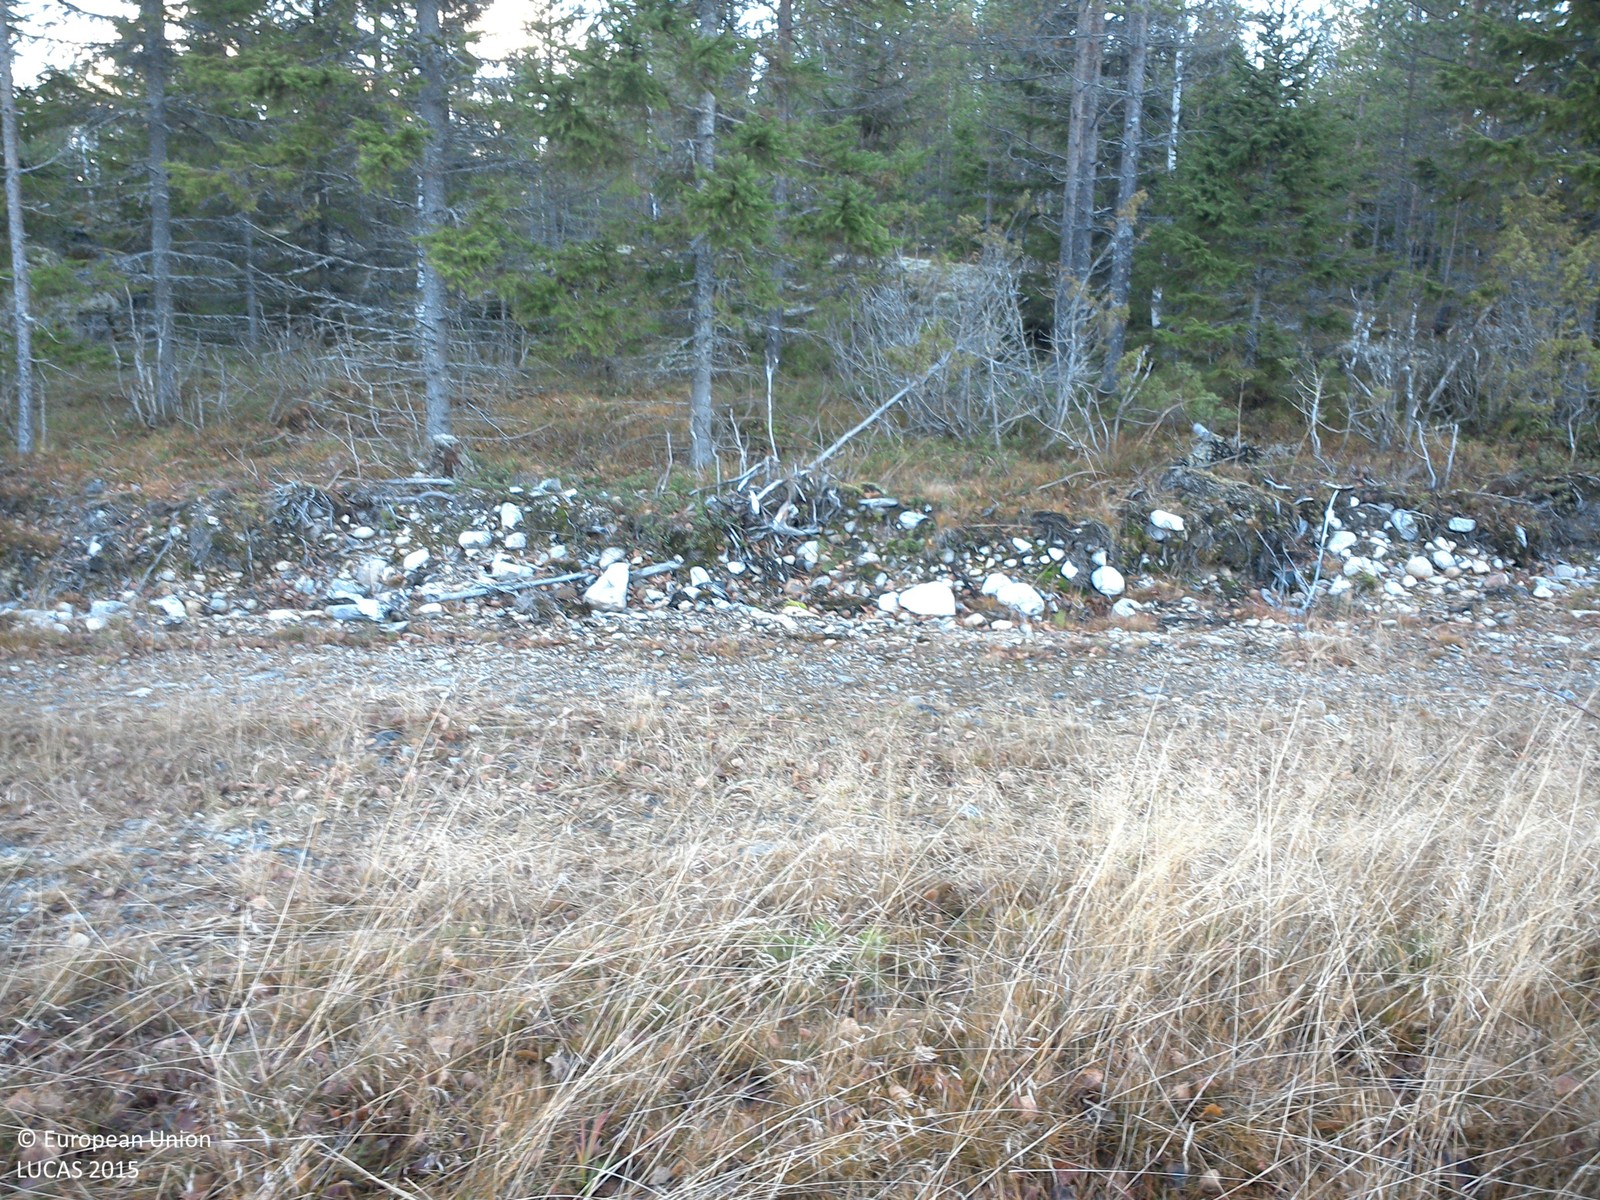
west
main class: Woodland
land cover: Pine dominated coniferous woodland
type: boreal forest
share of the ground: 25 - 50 %
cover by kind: shrubs 40 %, herbaceous plants 30 %, coniferous forest trees 25 %, broadleaved forest trees 5 %
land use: Forestry
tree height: < 5 m
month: November
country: SE
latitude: 63.7581
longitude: 19.9333
